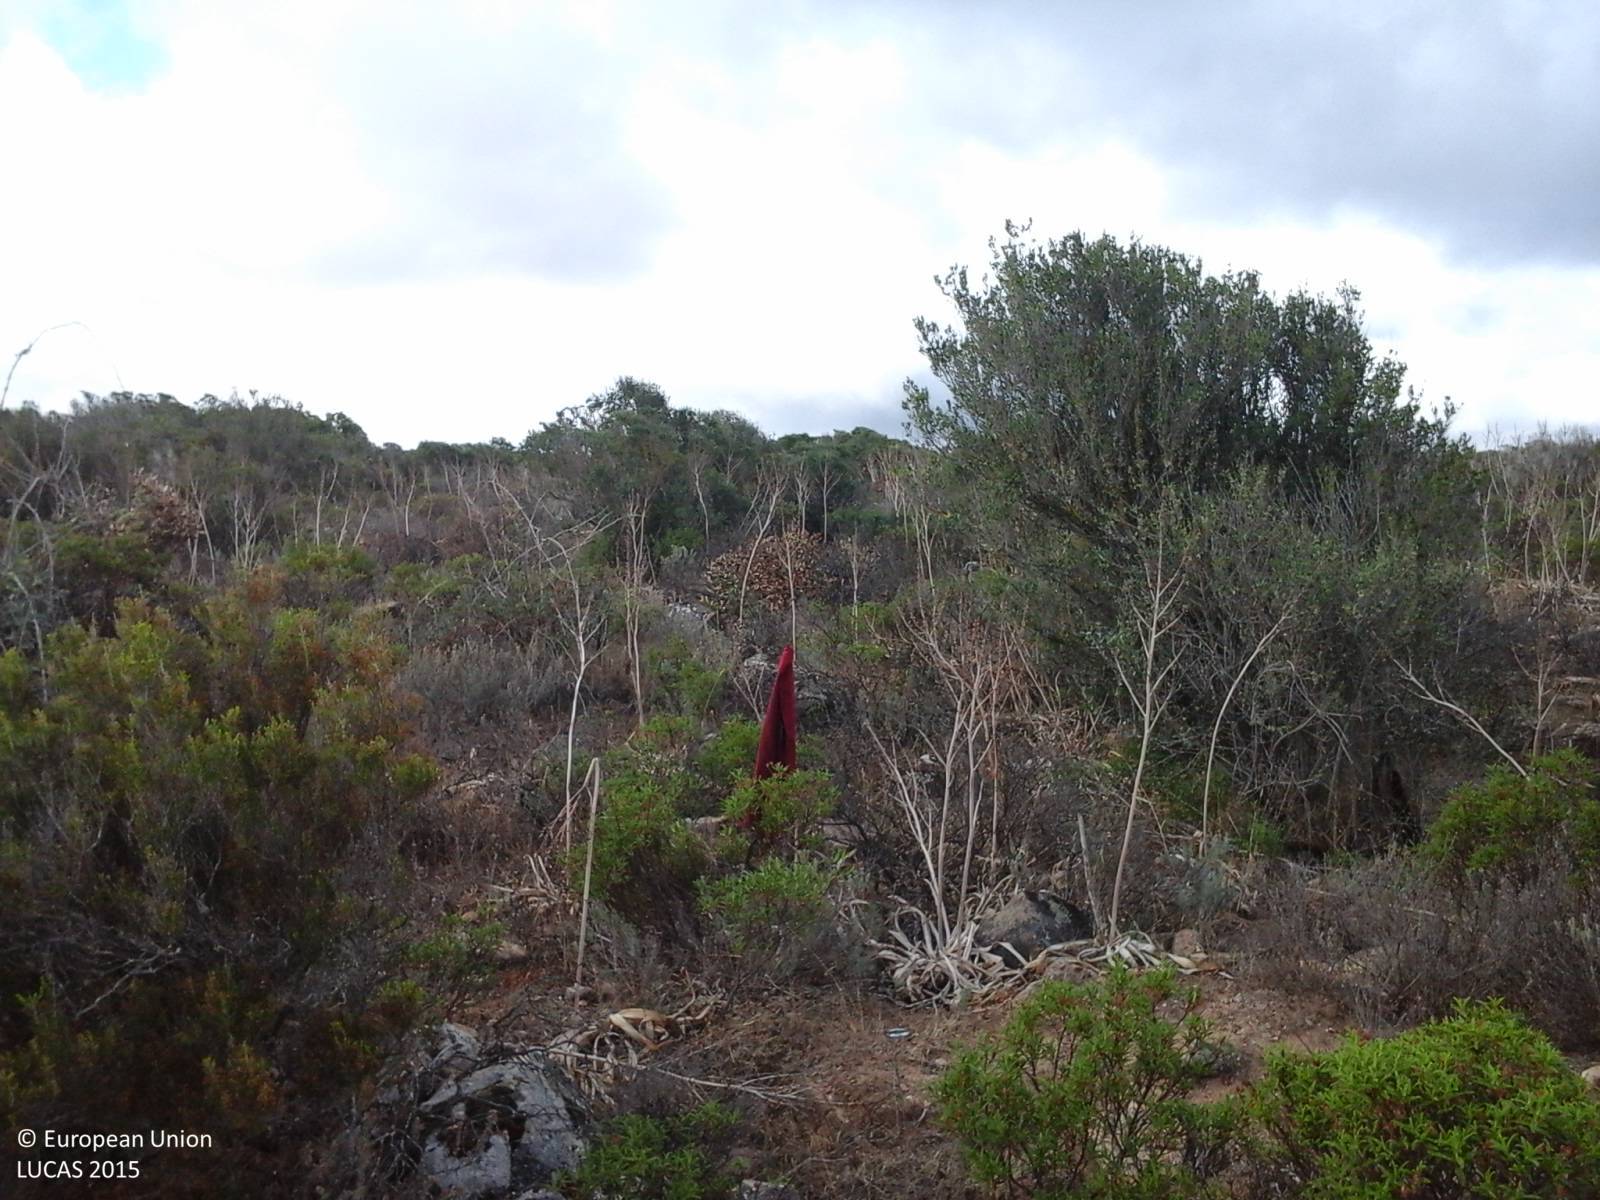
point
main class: Shrubland
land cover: Shrubland without tree cover
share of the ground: > 75 %
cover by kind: shrubs 70 %, herbaceous plants 30 %
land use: Semi-natural and natural areas not in use
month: August
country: IT
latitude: 40.6620
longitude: 9.1643
